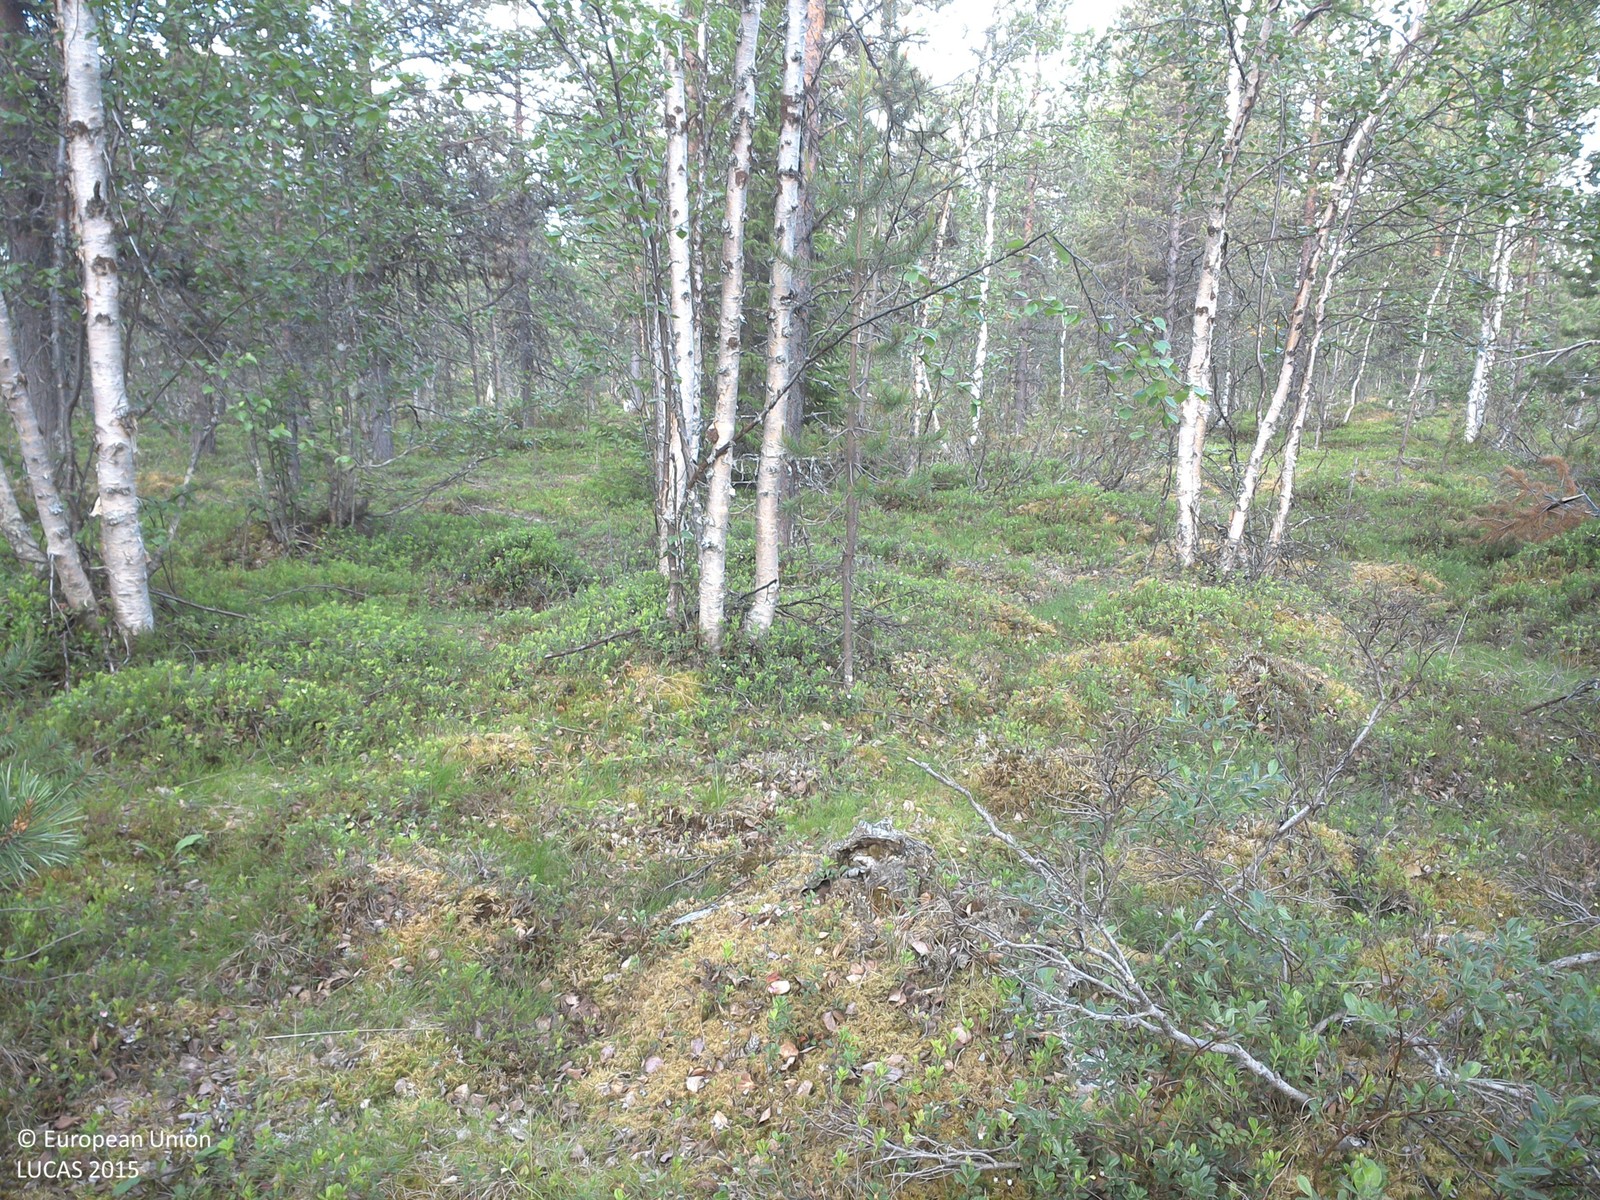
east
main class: Woodland
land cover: Pine dominated mixed woodland
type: boreal forest
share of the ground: 25 - 50 %
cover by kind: shrubs 55 %, coniferous forest trees 20 %, broadleaved forest trees 15 %, lichens and mosses 10 %
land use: Forestry
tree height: > 5 m
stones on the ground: < 10 %
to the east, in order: Pine dominated mixed woodland
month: July
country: SE
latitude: 67.8480
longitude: 22.2848
